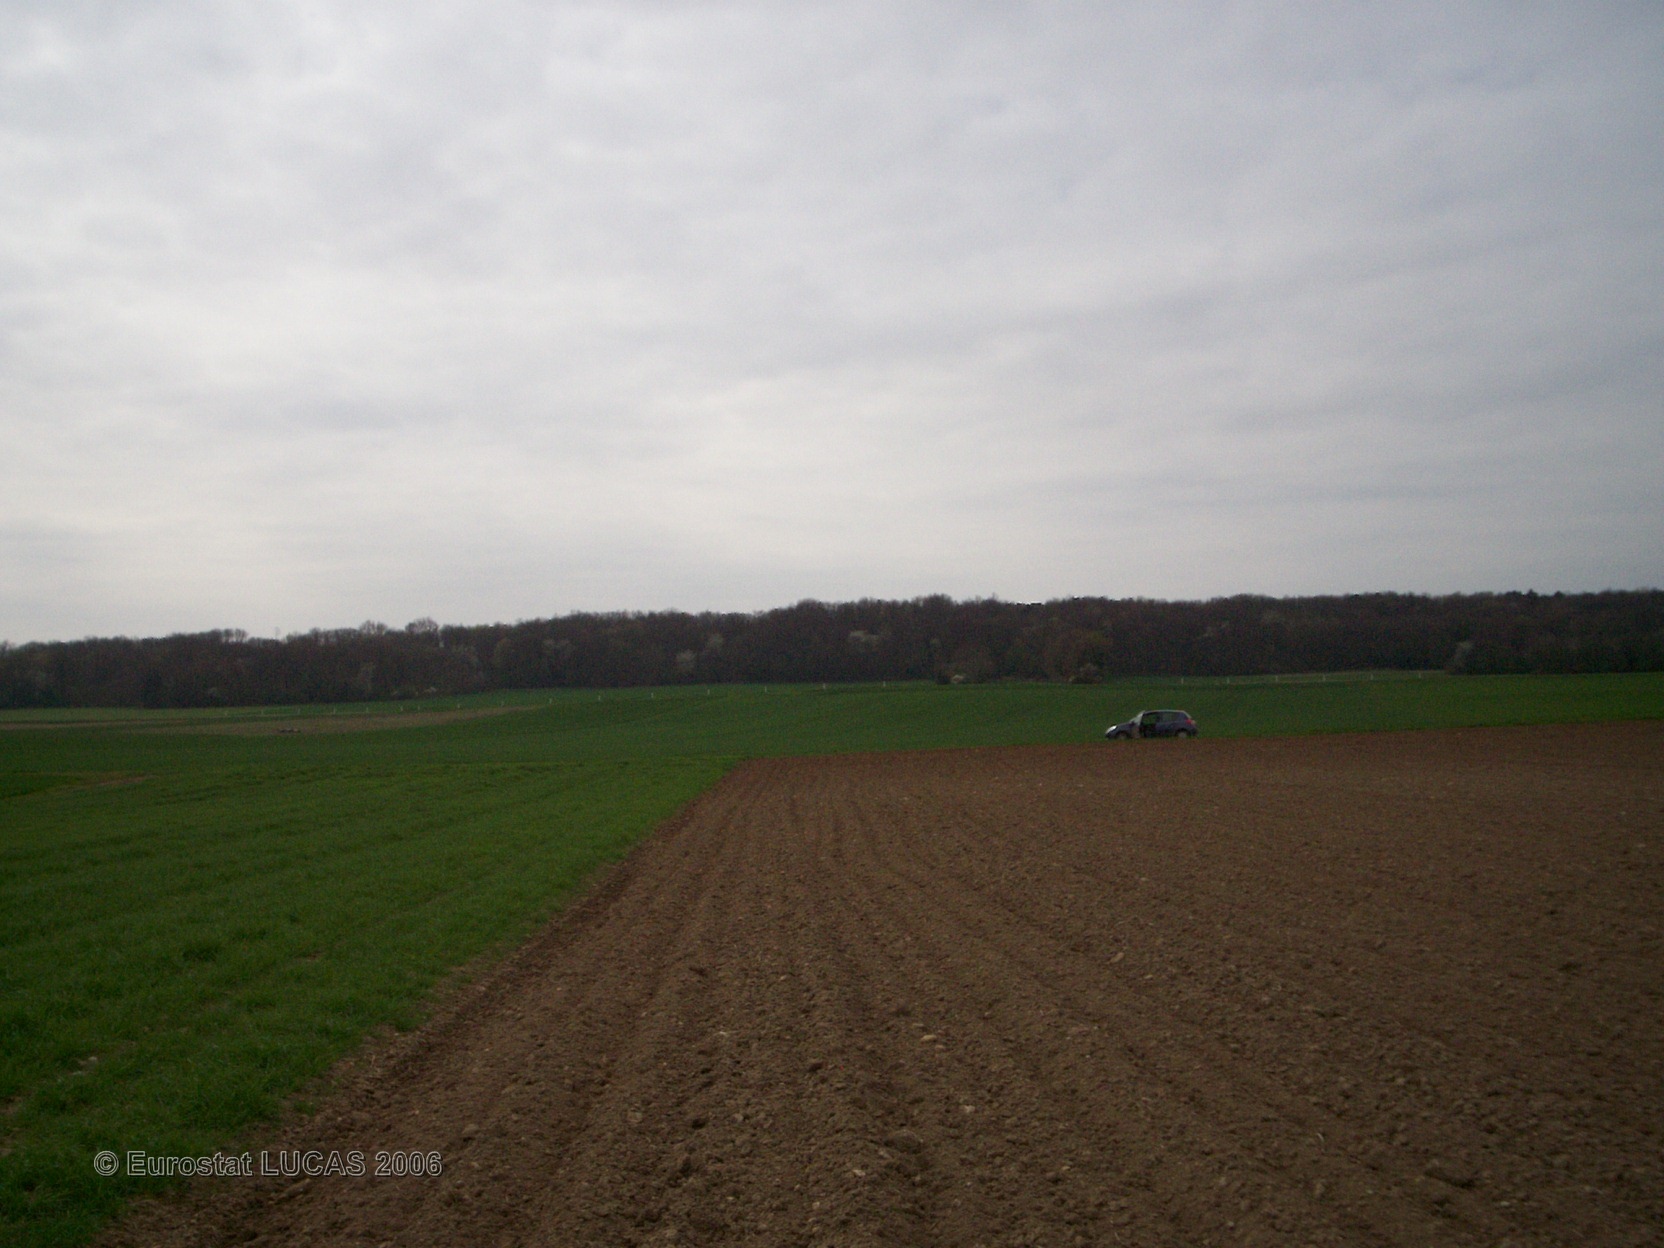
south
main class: Cropland
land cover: Sunflower
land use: Agriculture (excluding fallow land and kitchen gardens)
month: May
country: FR
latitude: 48.2794
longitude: 2.8361
